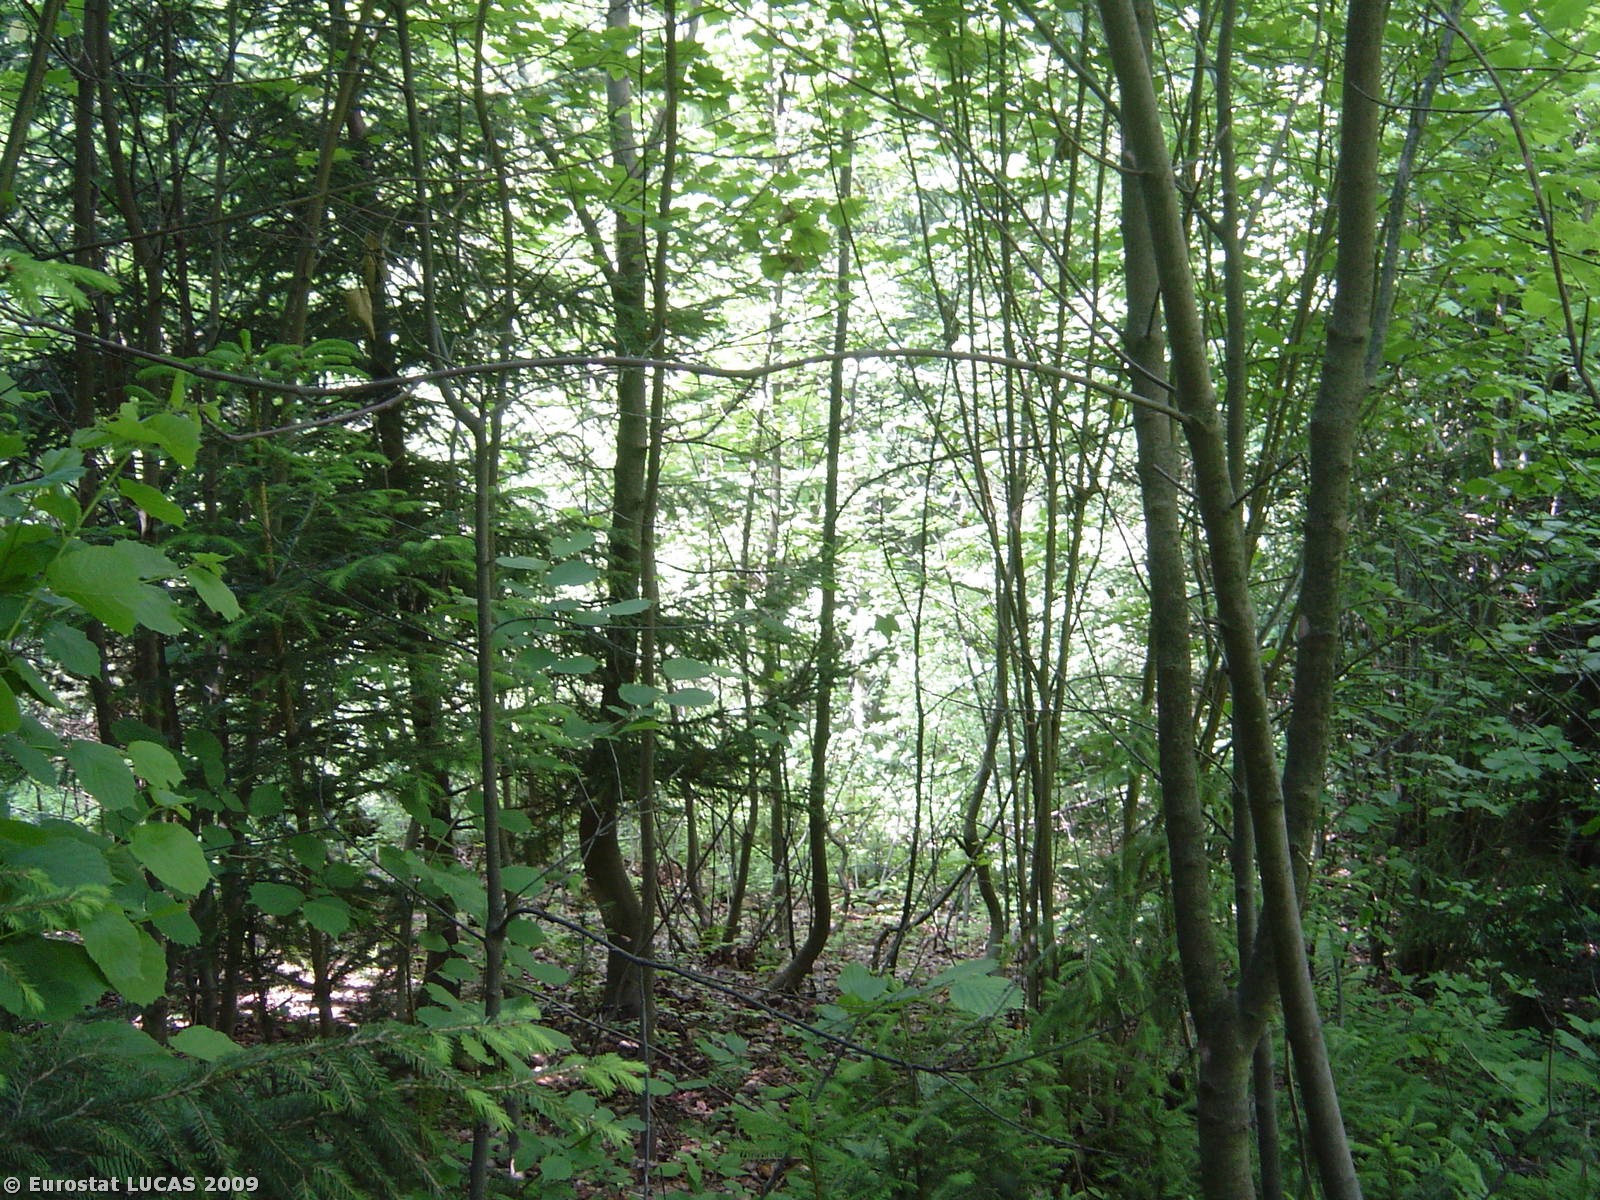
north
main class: Woodland
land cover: Mixed woodland
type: hemiboreal forest and nemoral coniferous forest and mixed broadleaved-coniferous forest
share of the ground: > 75 %
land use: Forestry
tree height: > 5 m
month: June
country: CZ
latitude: 49.8169
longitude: 16.5258
